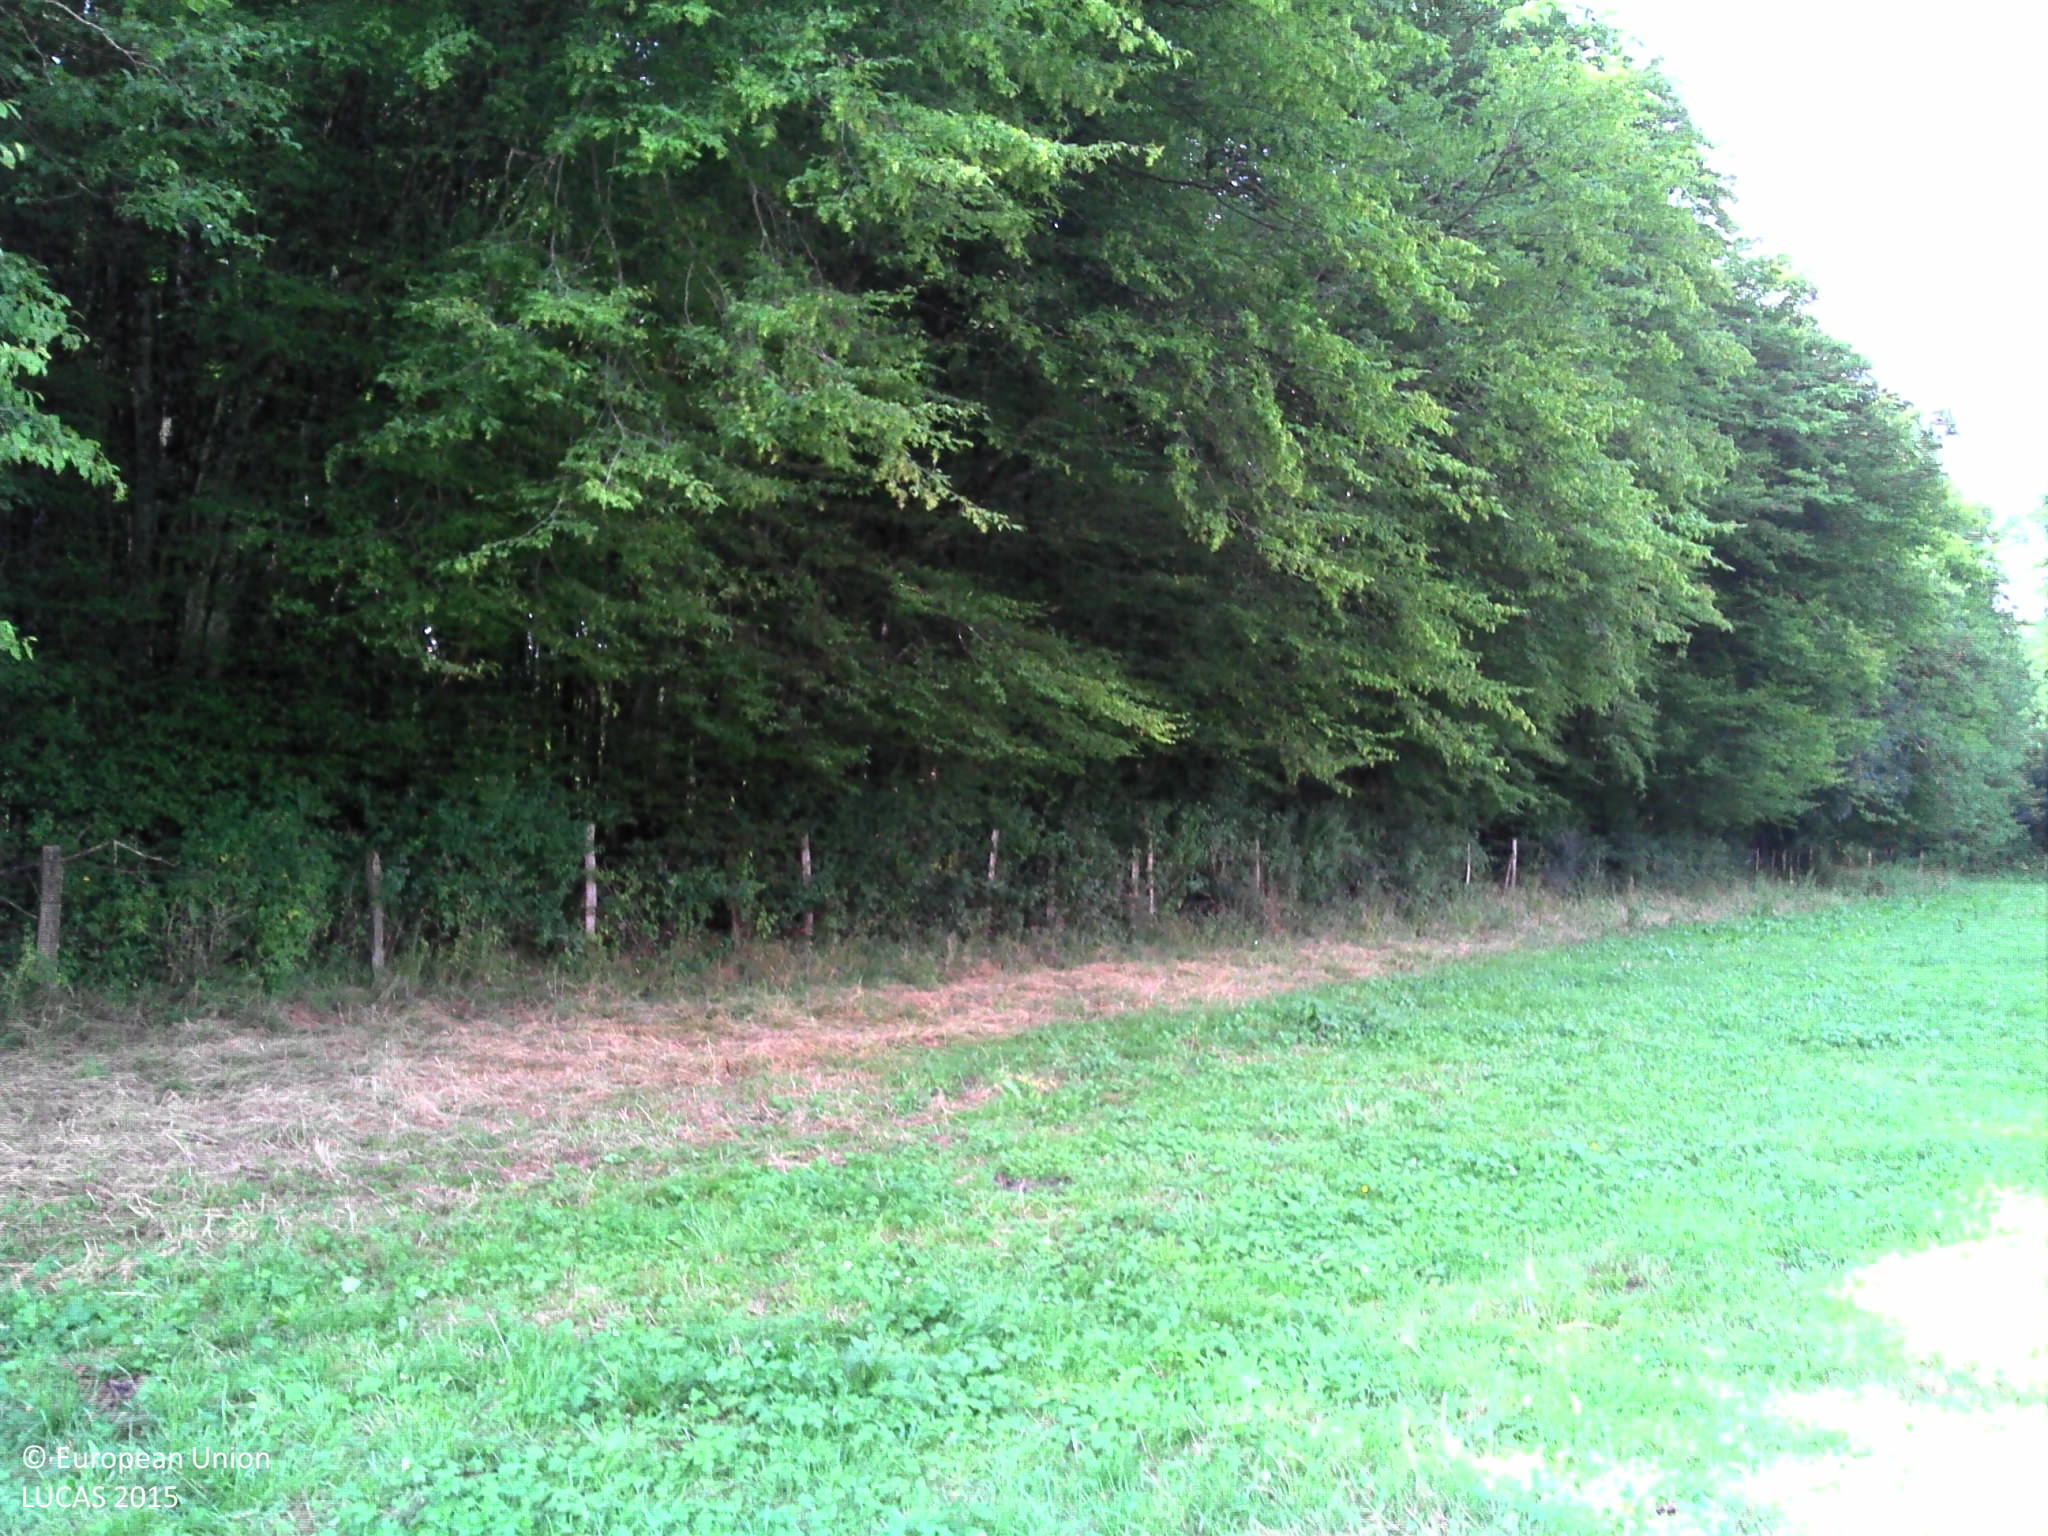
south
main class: Grassland
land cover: Grassland without tree/shrub cover
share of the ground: > 75 %
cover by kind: herbaceous plants 100 %
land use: Agriculture (excluding fallow land and kitchen gardens)
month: July
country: FR
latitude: 47.1350
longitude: 3.6031
